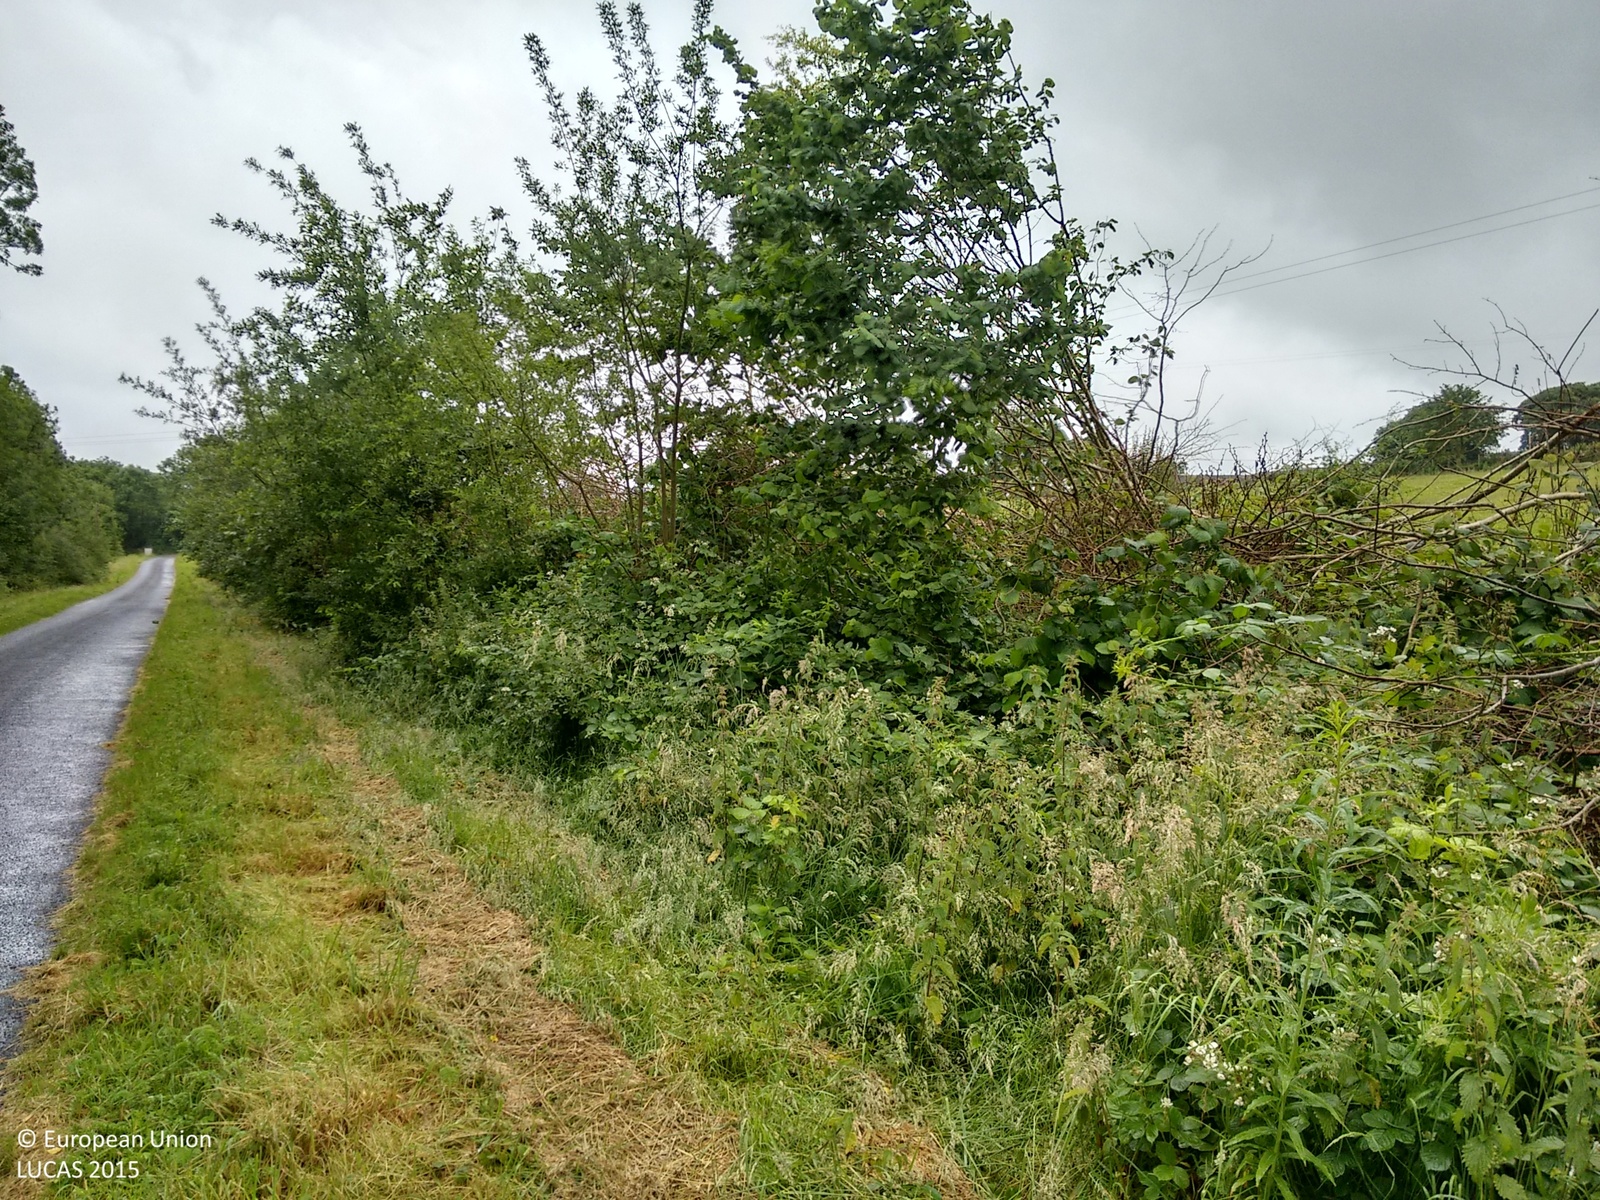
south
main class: Grassland
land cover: Grassland without tree/shrub cover
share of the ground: > 75 %
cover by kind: herbaceous plants 100 %
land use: Agriculture (excluding fallow land and kitchen gardens)
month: July
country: IE
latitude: 53.5839
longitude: -8.1402
